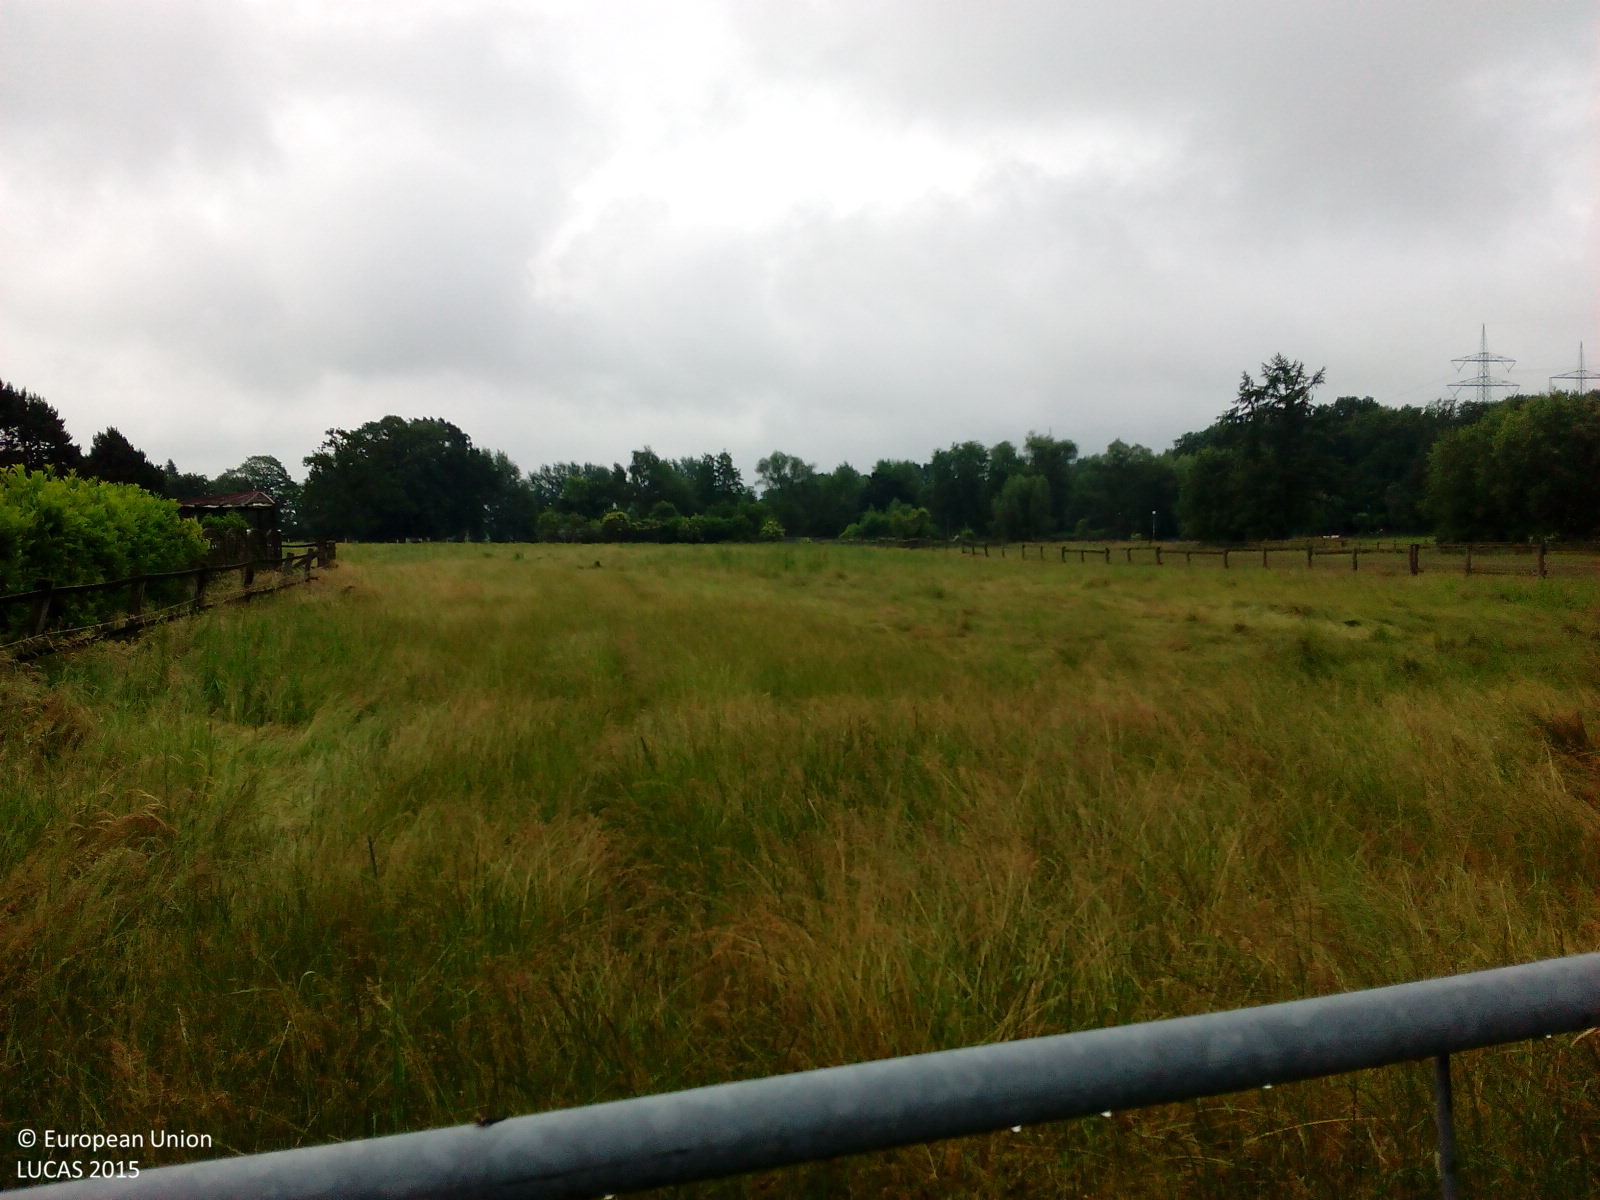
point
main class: Grassland
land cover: Grassland without tree/shrub cover
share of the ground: > 75 %
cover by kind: herbaceous plants 100 %
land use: Agriculture (excluding fallow land and kitchen gardens)
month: June
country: DE
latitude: 51.6398
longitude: 7.0667
